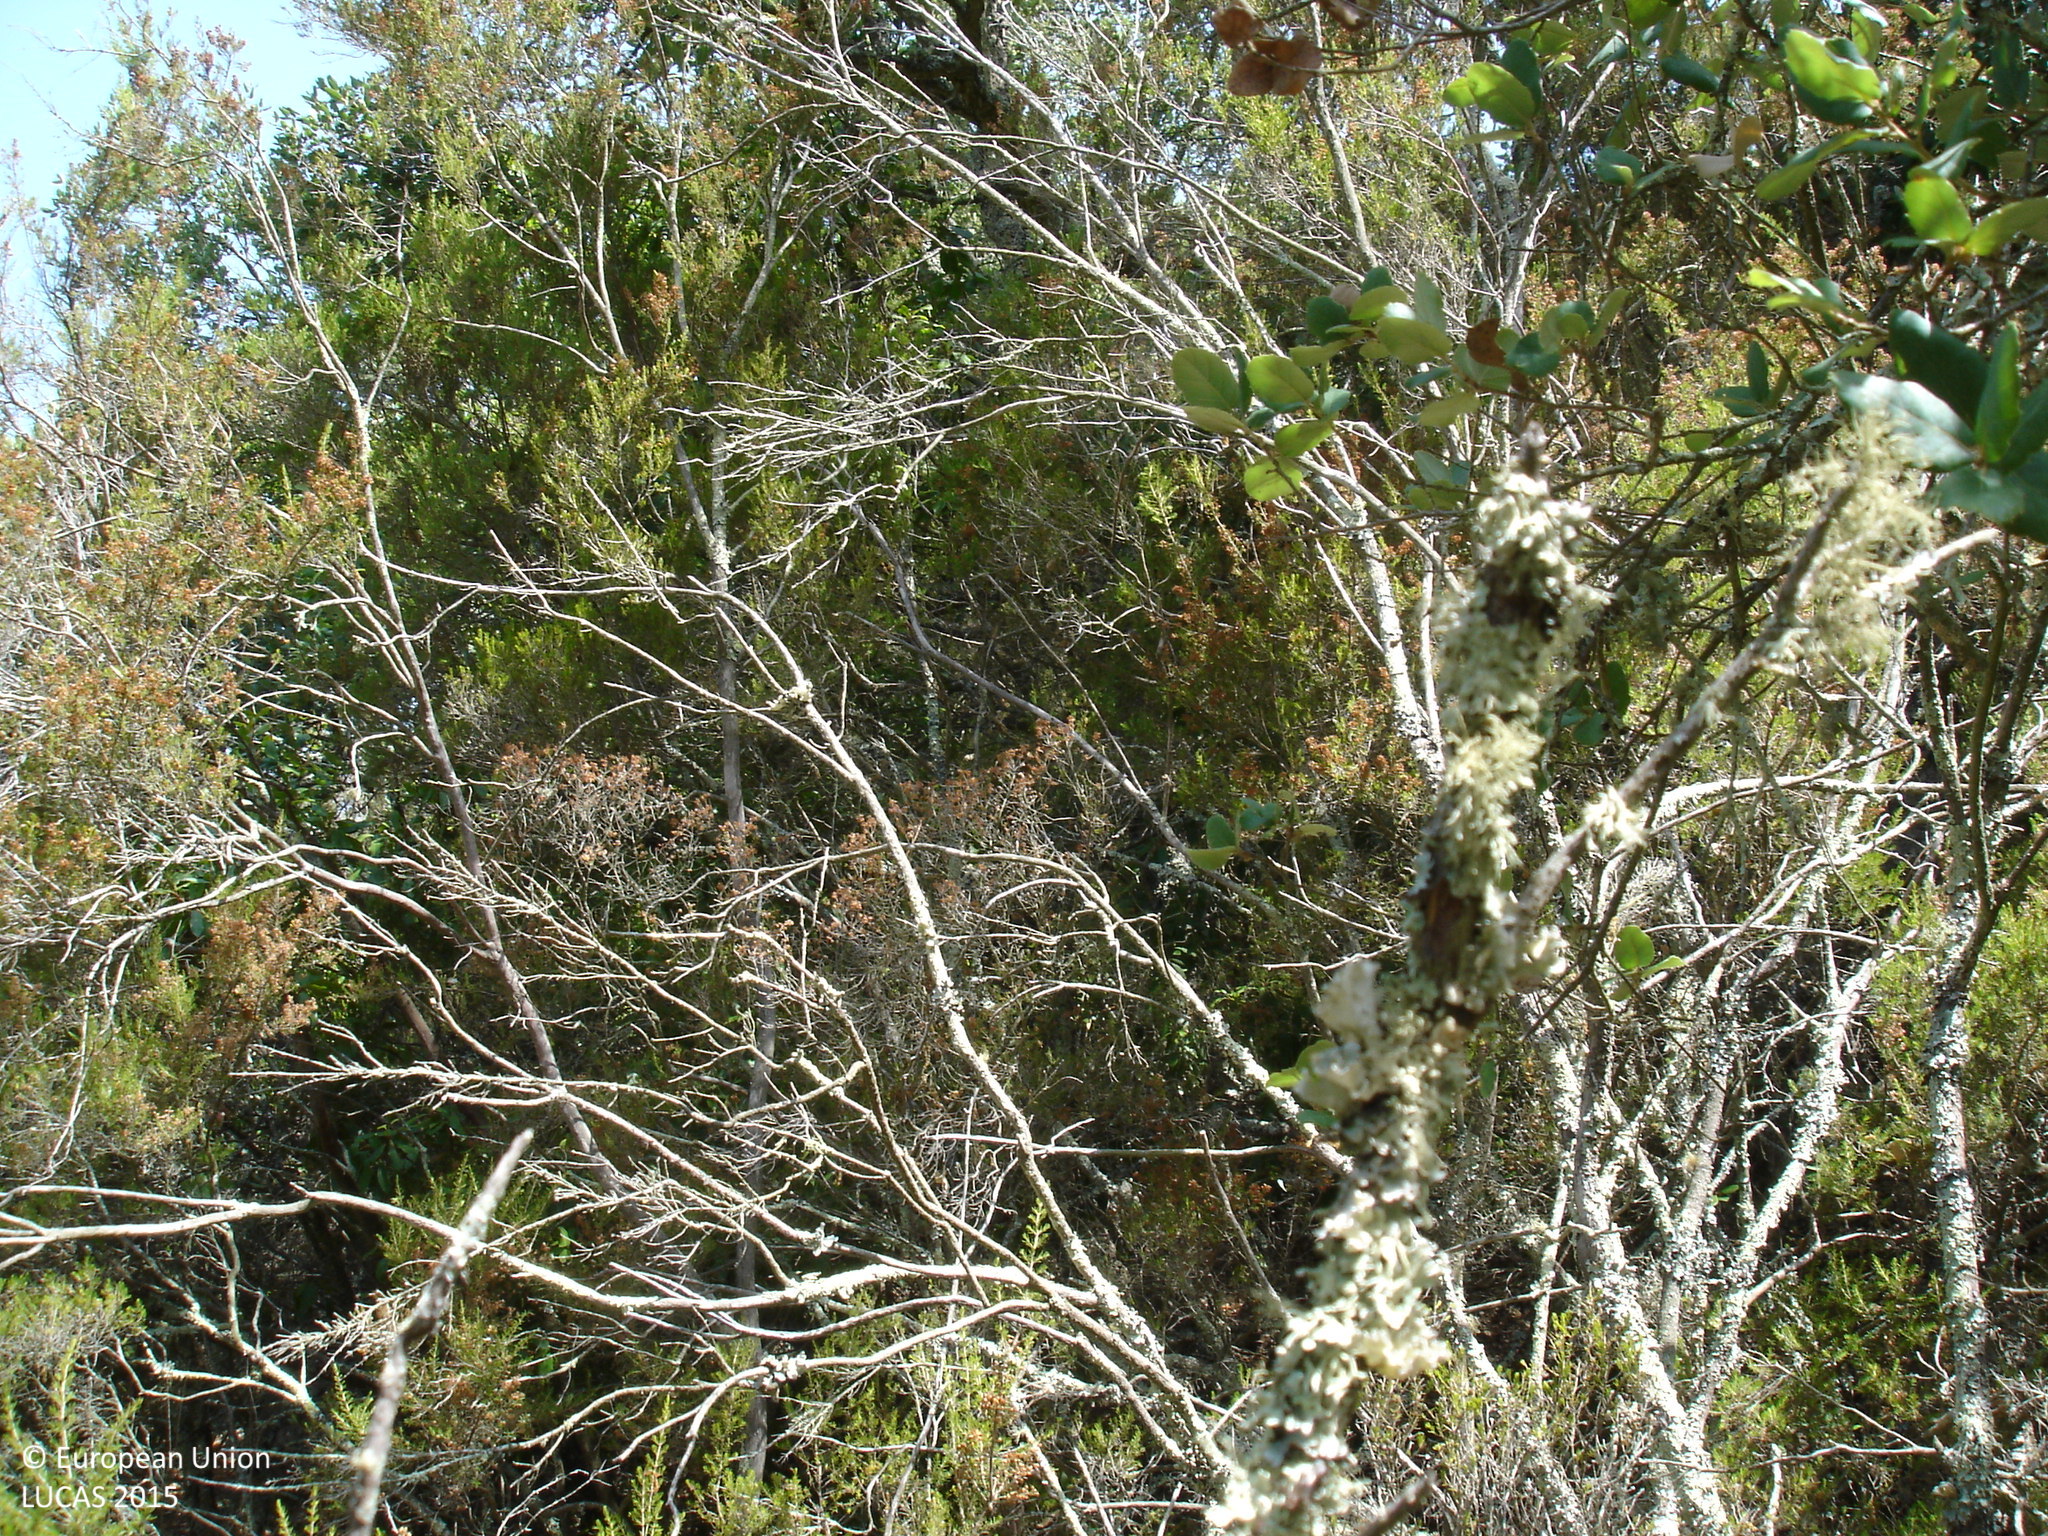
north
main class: Woodland
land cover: Other mixed woodland
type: thermophilous deciduous forest
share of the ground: > 75 %
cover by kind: broadleaved forest trees 70 %, coniferous forest trees 30 %
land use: Forestry
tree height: > 5 m
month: July
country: ES
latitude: 41.8331
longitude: 3.0205
